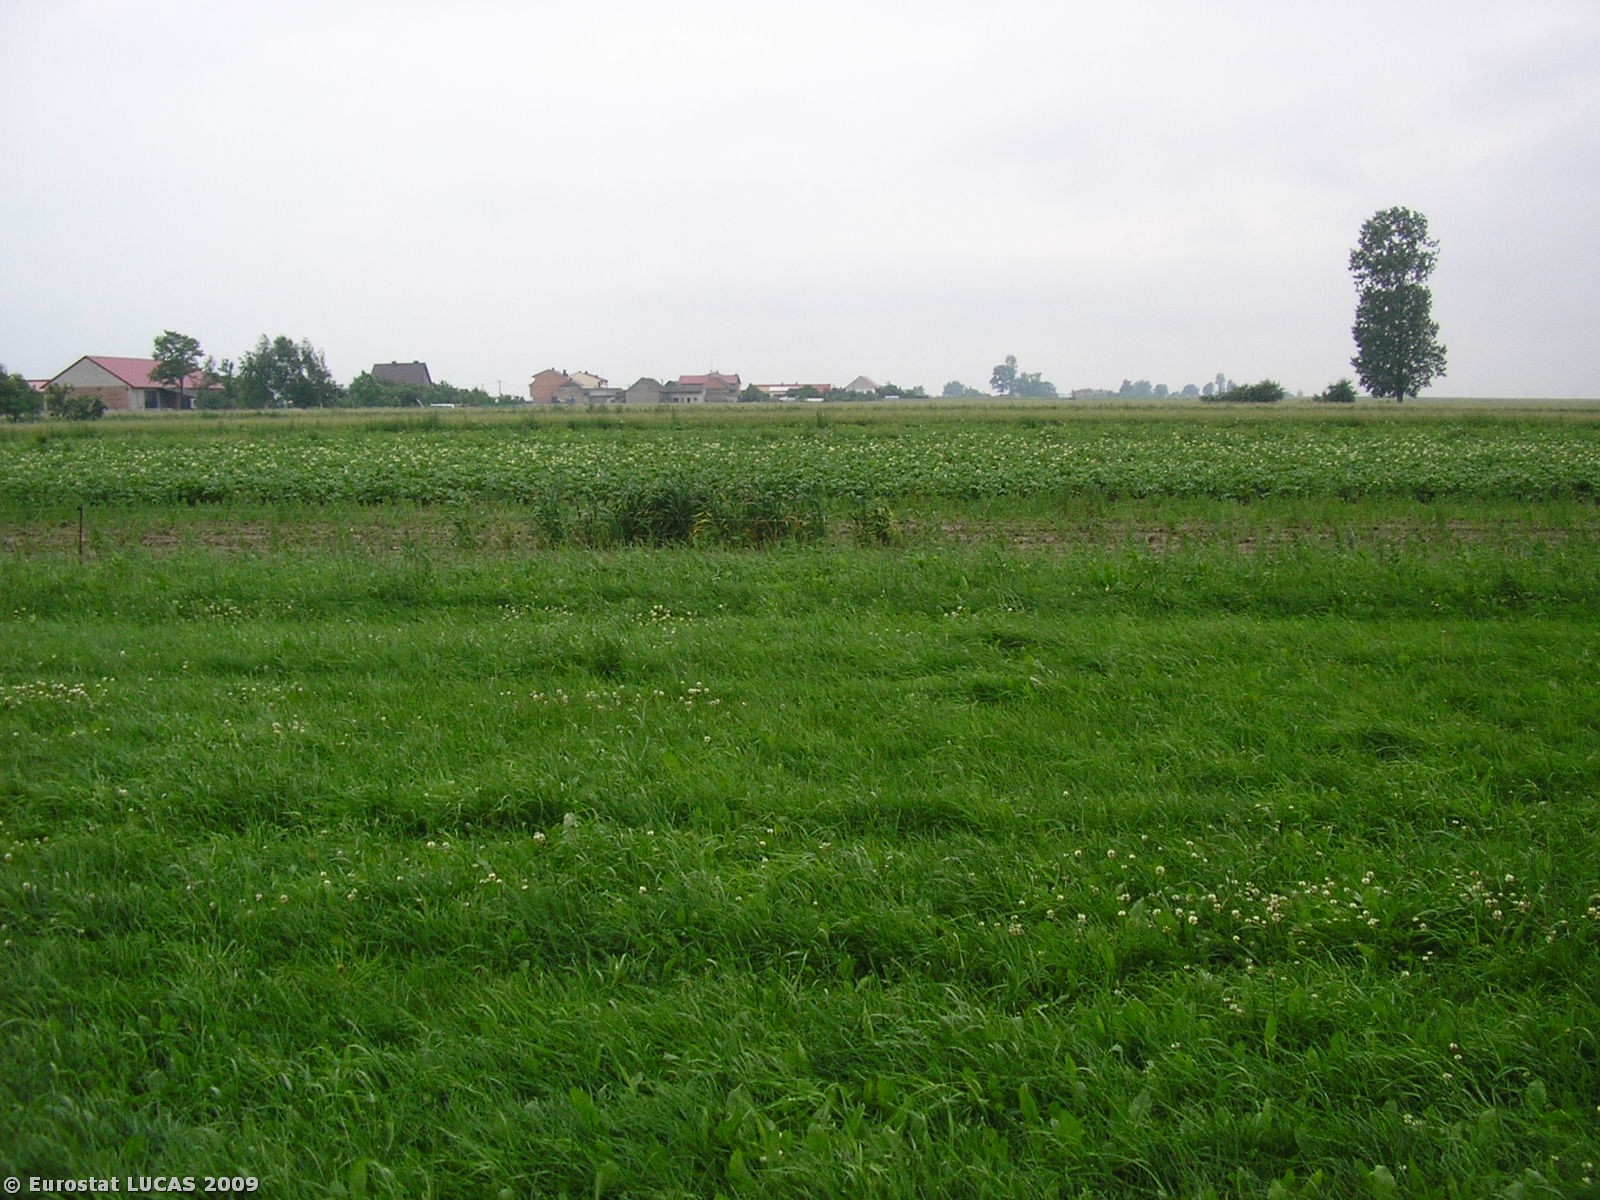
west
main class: Grassland
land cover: Grassland without tree/shrub cover
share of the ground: > 75 %
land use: Agriculture (excluding fallow land and kitchen gardens)
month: June
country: PL
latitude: 51.2458
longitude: 18.4281
